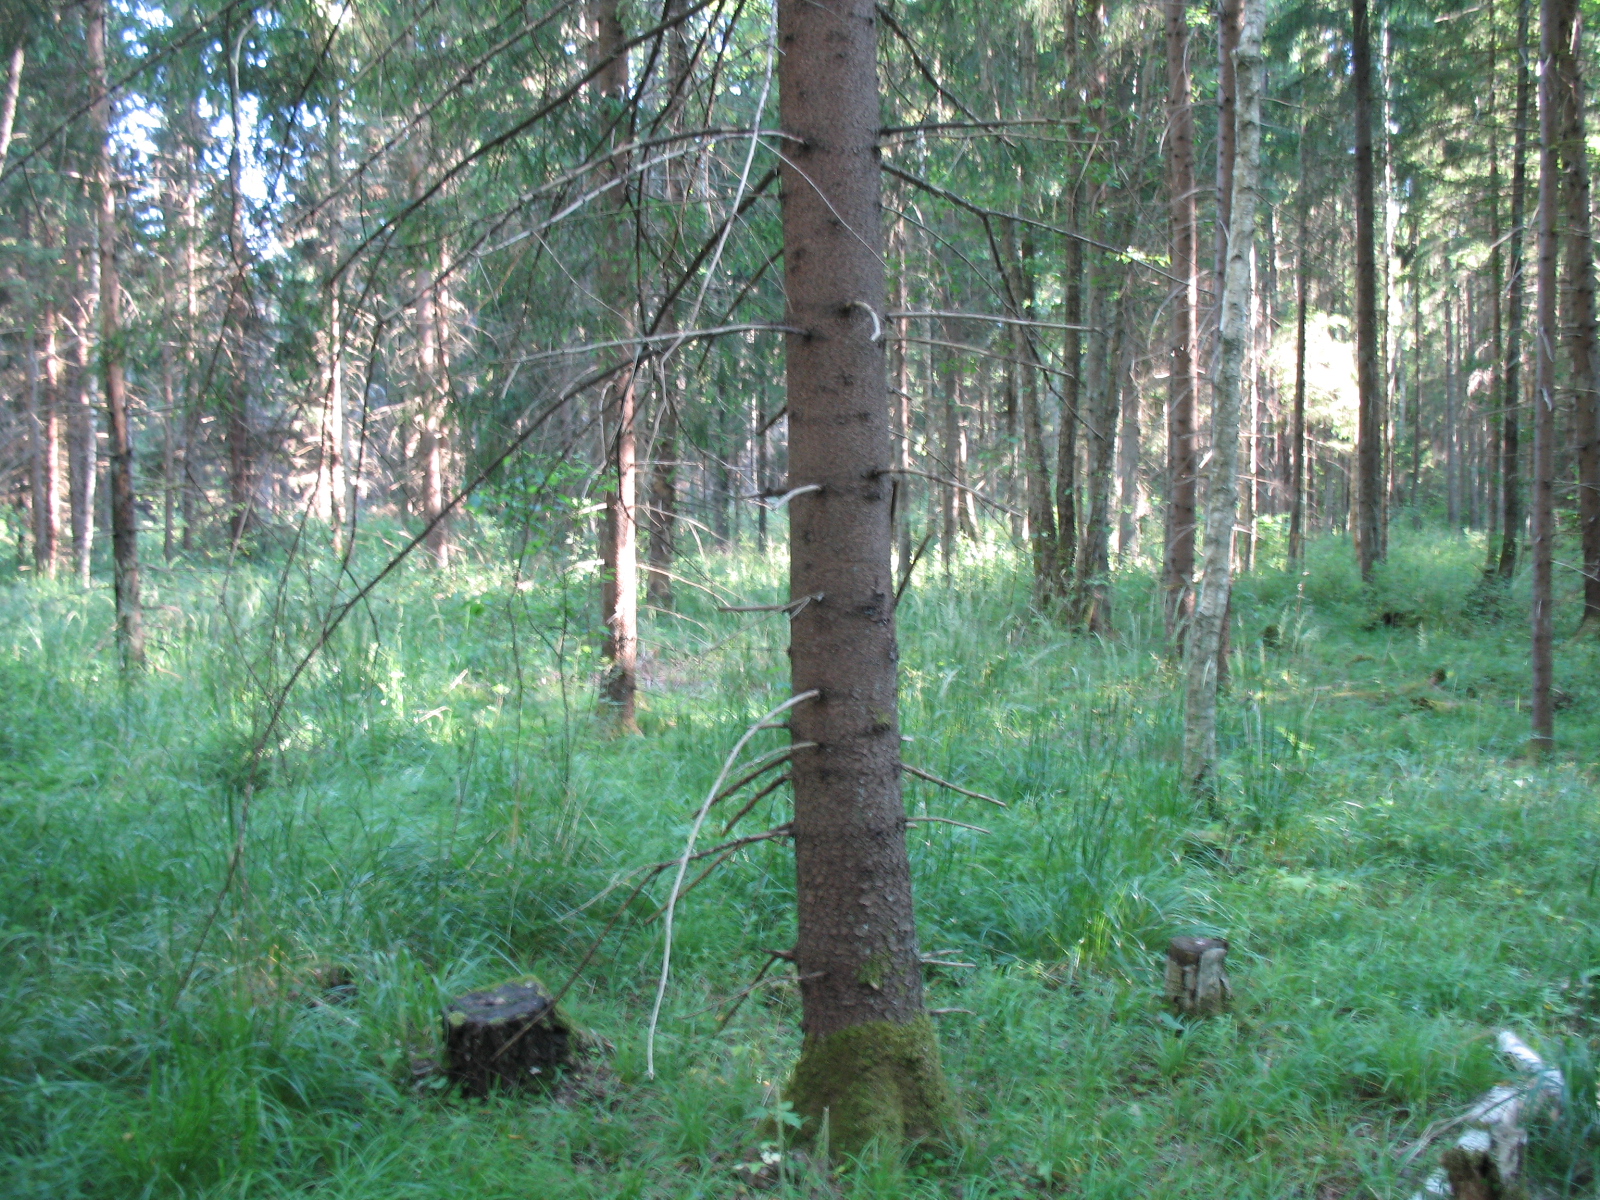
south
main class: Woodland
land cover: Spruce dominated mixed woodland
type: hemiboreal forest and nemoral coniferous forest and mixed broadleaved-coniferous forest
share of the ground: > 75 %
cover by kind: coniferous forest trees 45 %, broadleaved forest trees 45 %, herbaceous plants 5 %, lichens and mosses 5 %
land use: Forestry
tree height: > 5 m
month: July
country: LV
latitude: 56.7706
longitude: 23.8077
